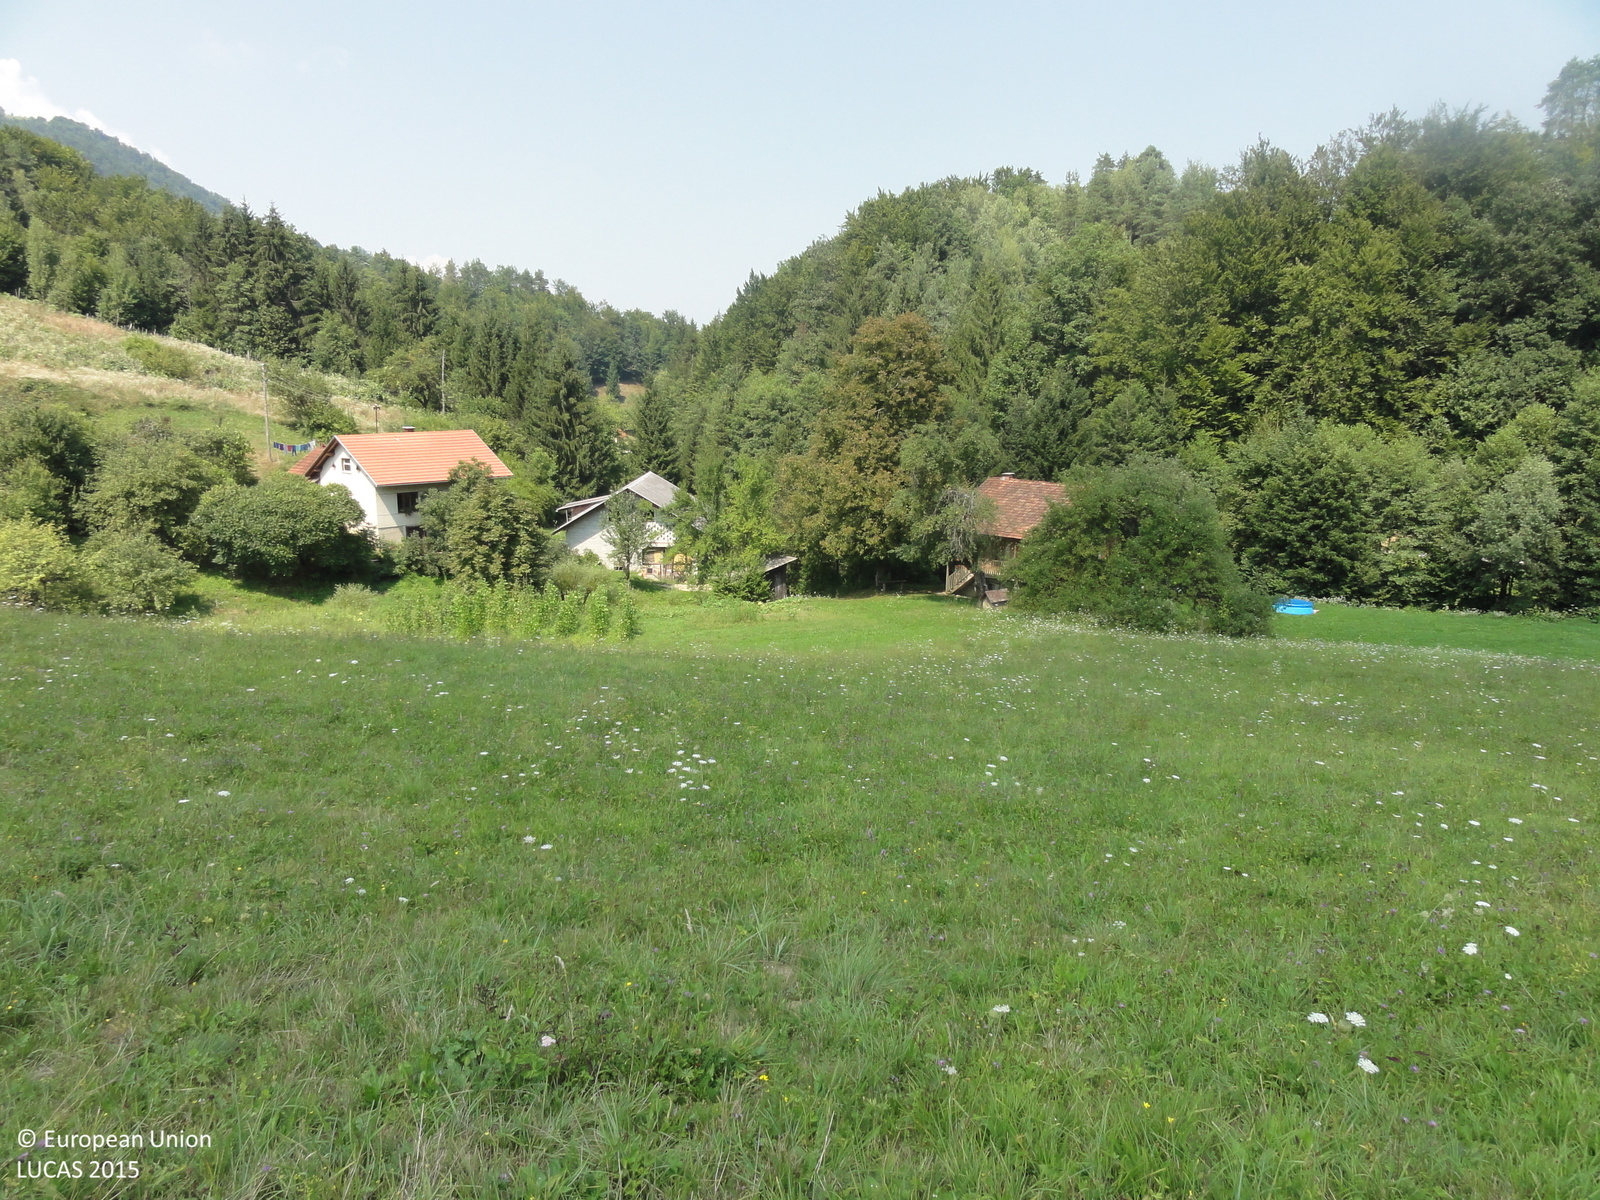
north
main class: Grassland
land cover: Grassland without tree/shrub cover
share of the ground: > 75 %
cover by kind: herbaceous plants 100 %
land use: Agriculture (excluding fallow land and kitchen gardens)
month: August
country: SI
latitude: 46.1375
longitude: 15.4992
